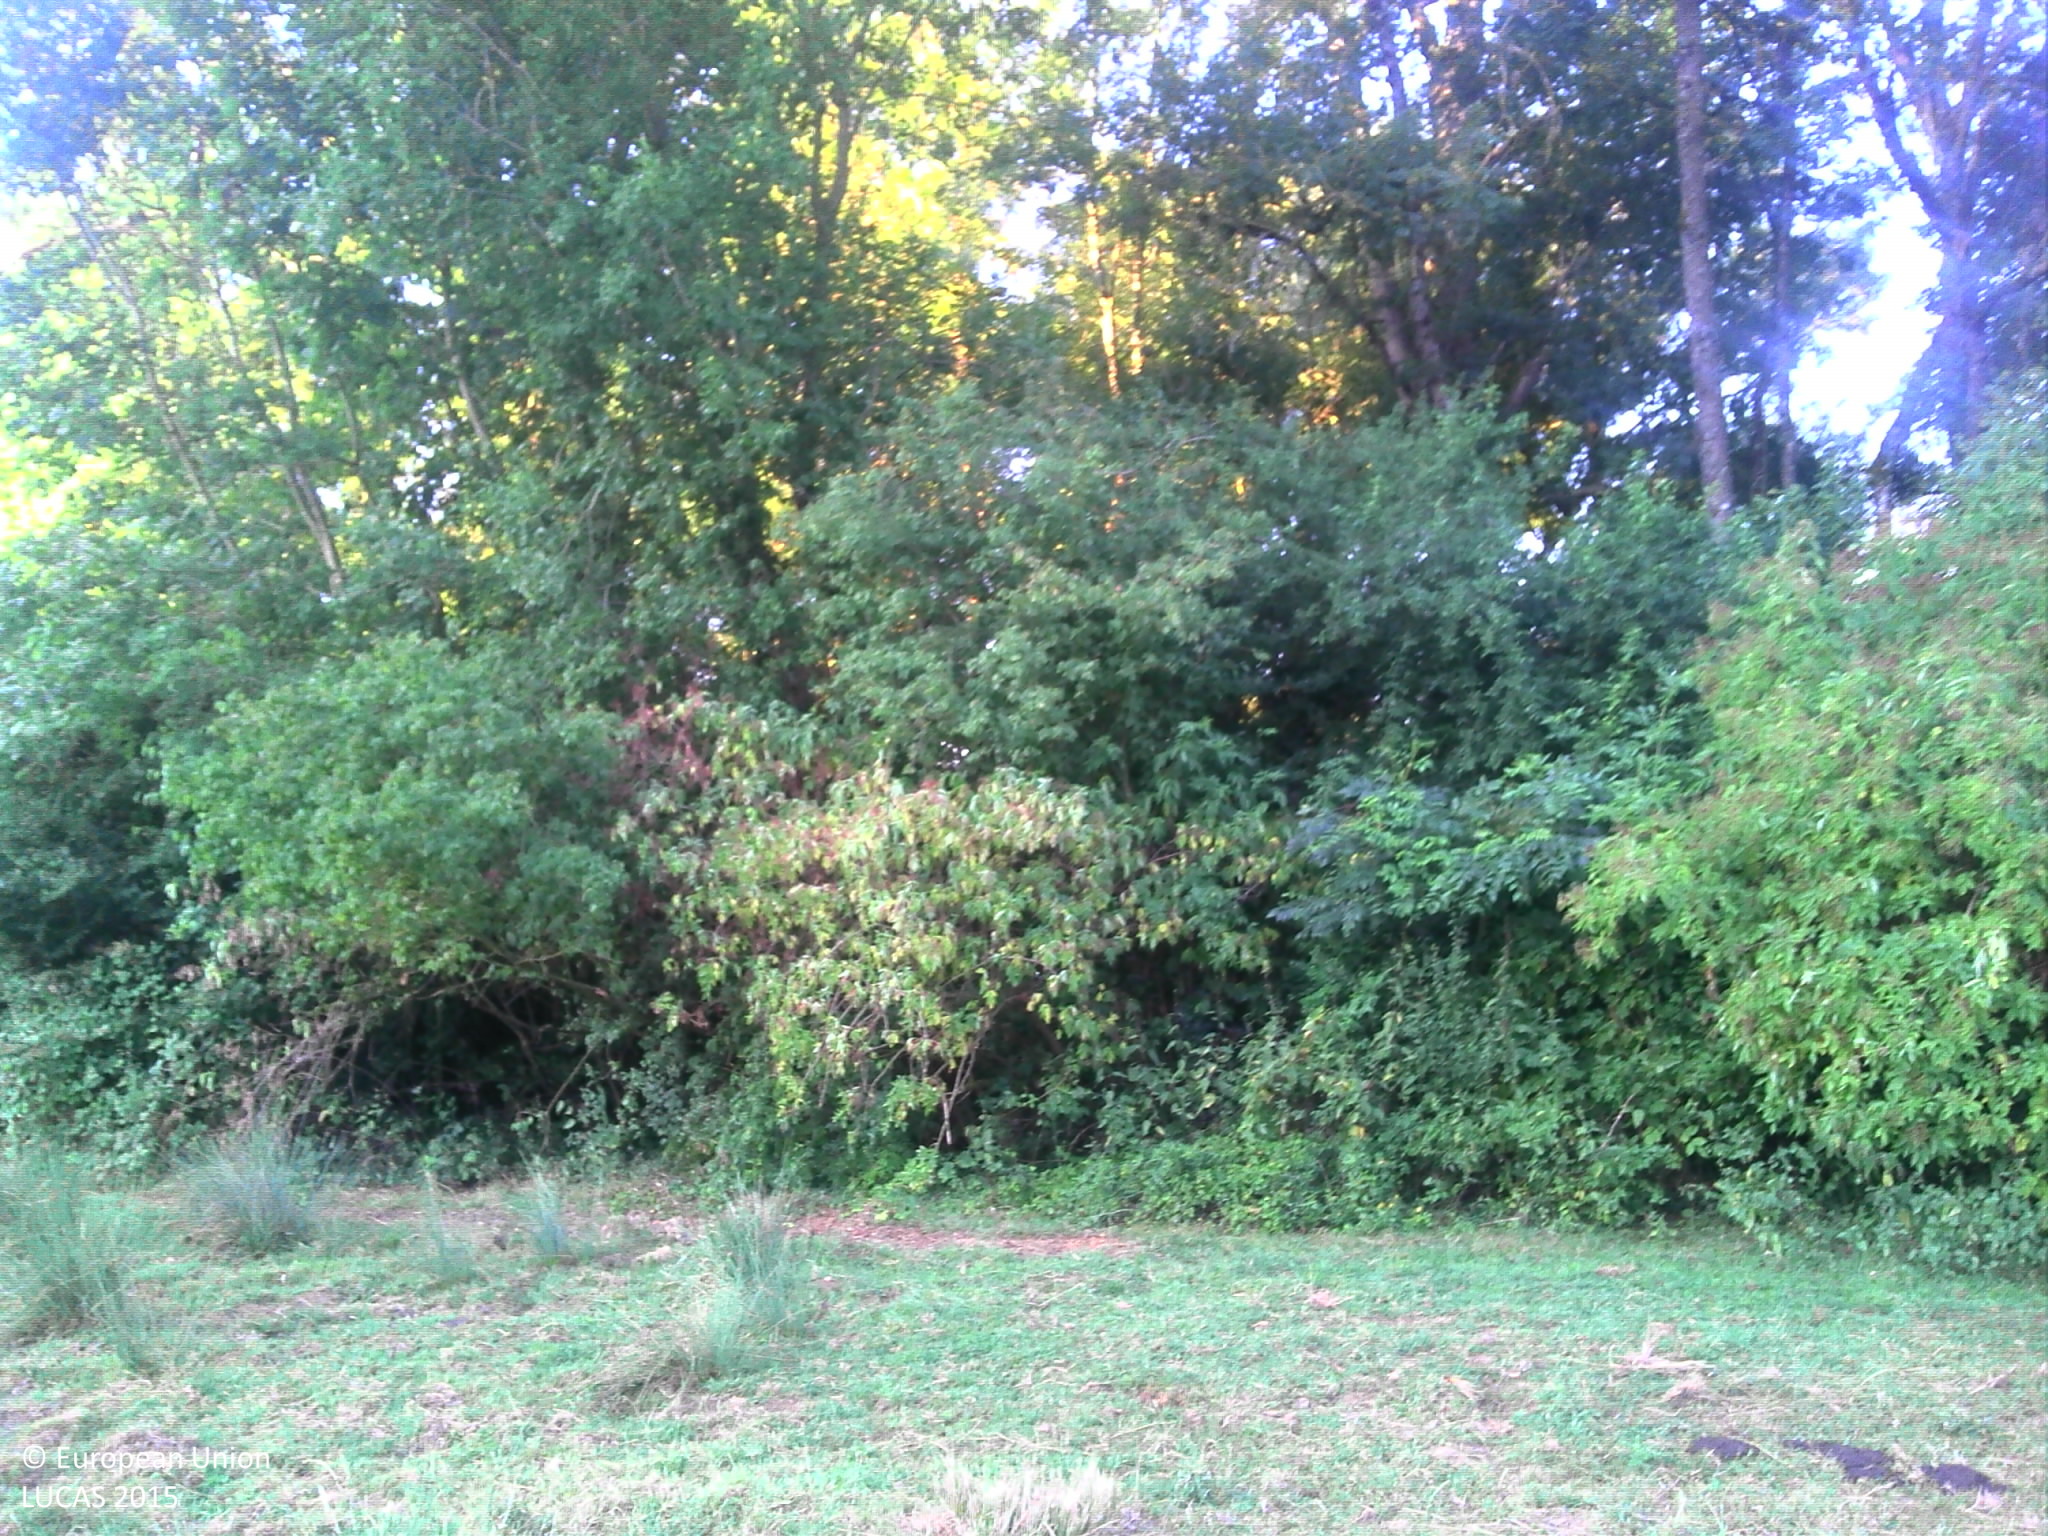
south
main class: Grassland
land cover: Grassland without tree/shrub cover
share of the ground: > 75 %
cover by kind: herbaceous plants 100 %
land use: Agriculture (excluding fallow land and kitchen gardens)
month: July
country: FR
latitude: 47.8747
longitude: 5.3873
